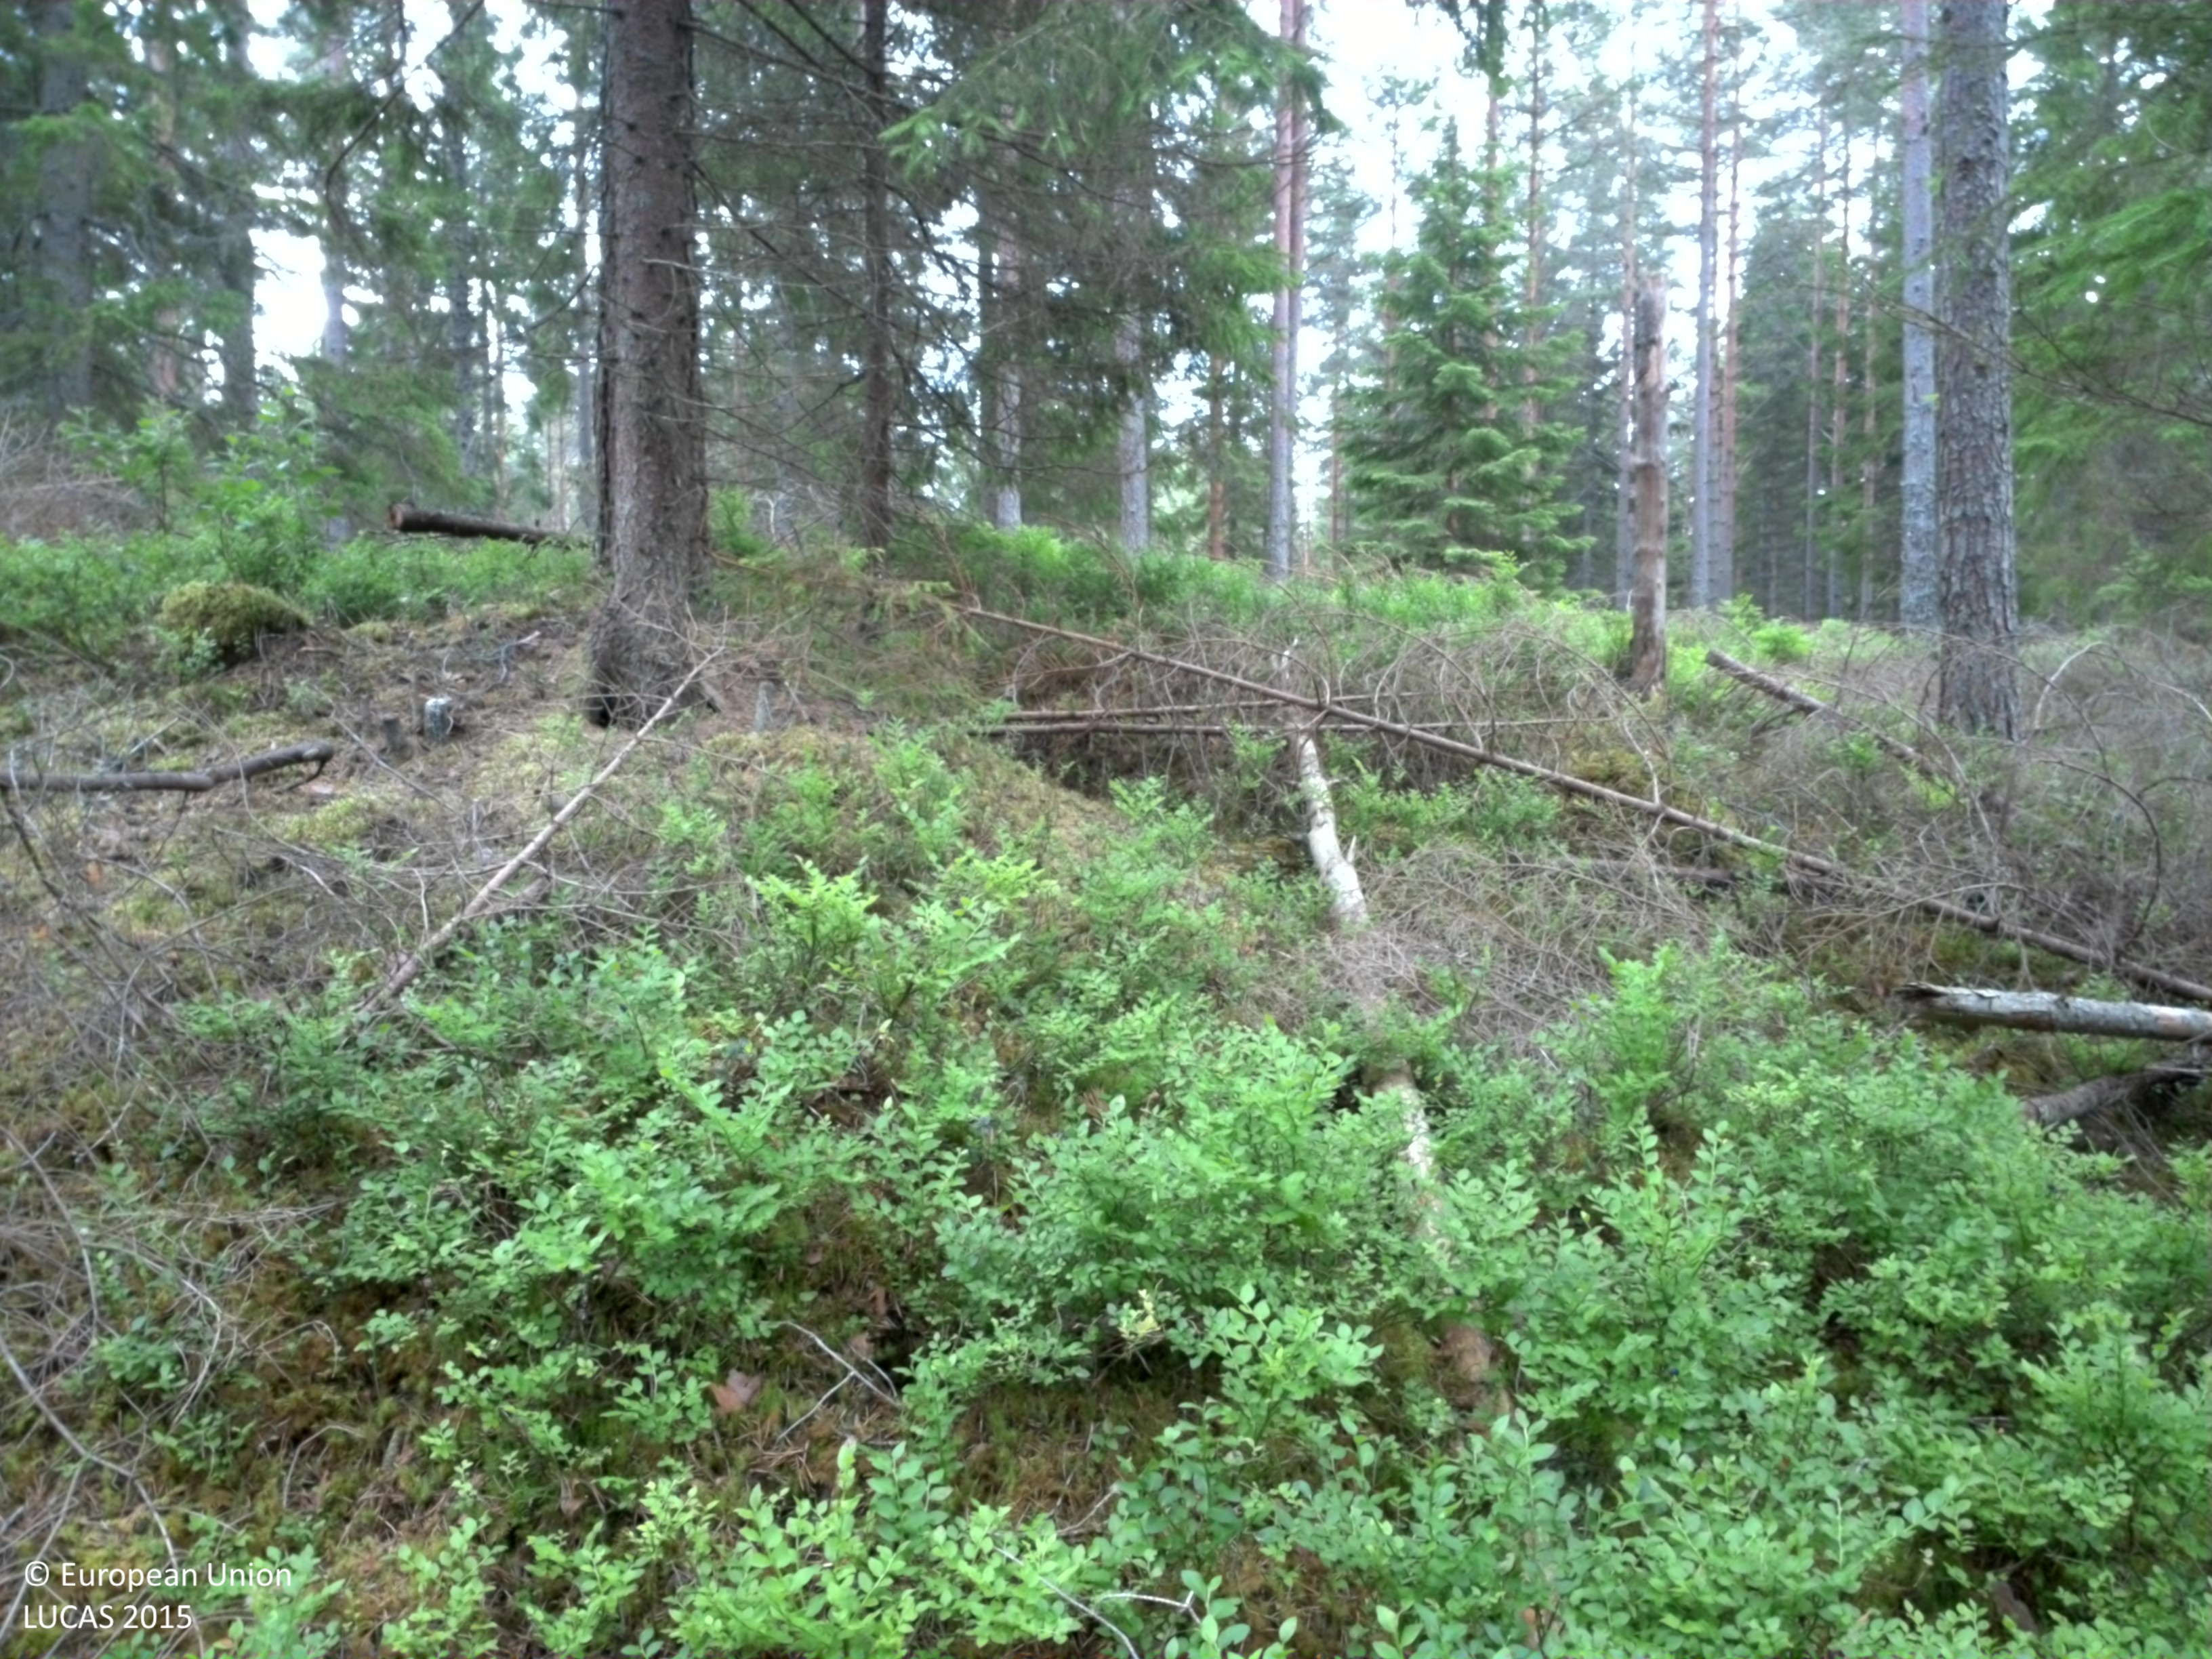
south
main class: Woodland
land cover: Pine dominated coniferous woodland
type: boreal forest
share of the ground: 50 - 75 %
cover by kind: coniferous forest trees 60 %, shrubs 35 %, lichens and mosses 5 %
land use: Forestry
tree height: > 5 m
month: July
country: SE
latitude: 58.7982
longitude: 14.3367
